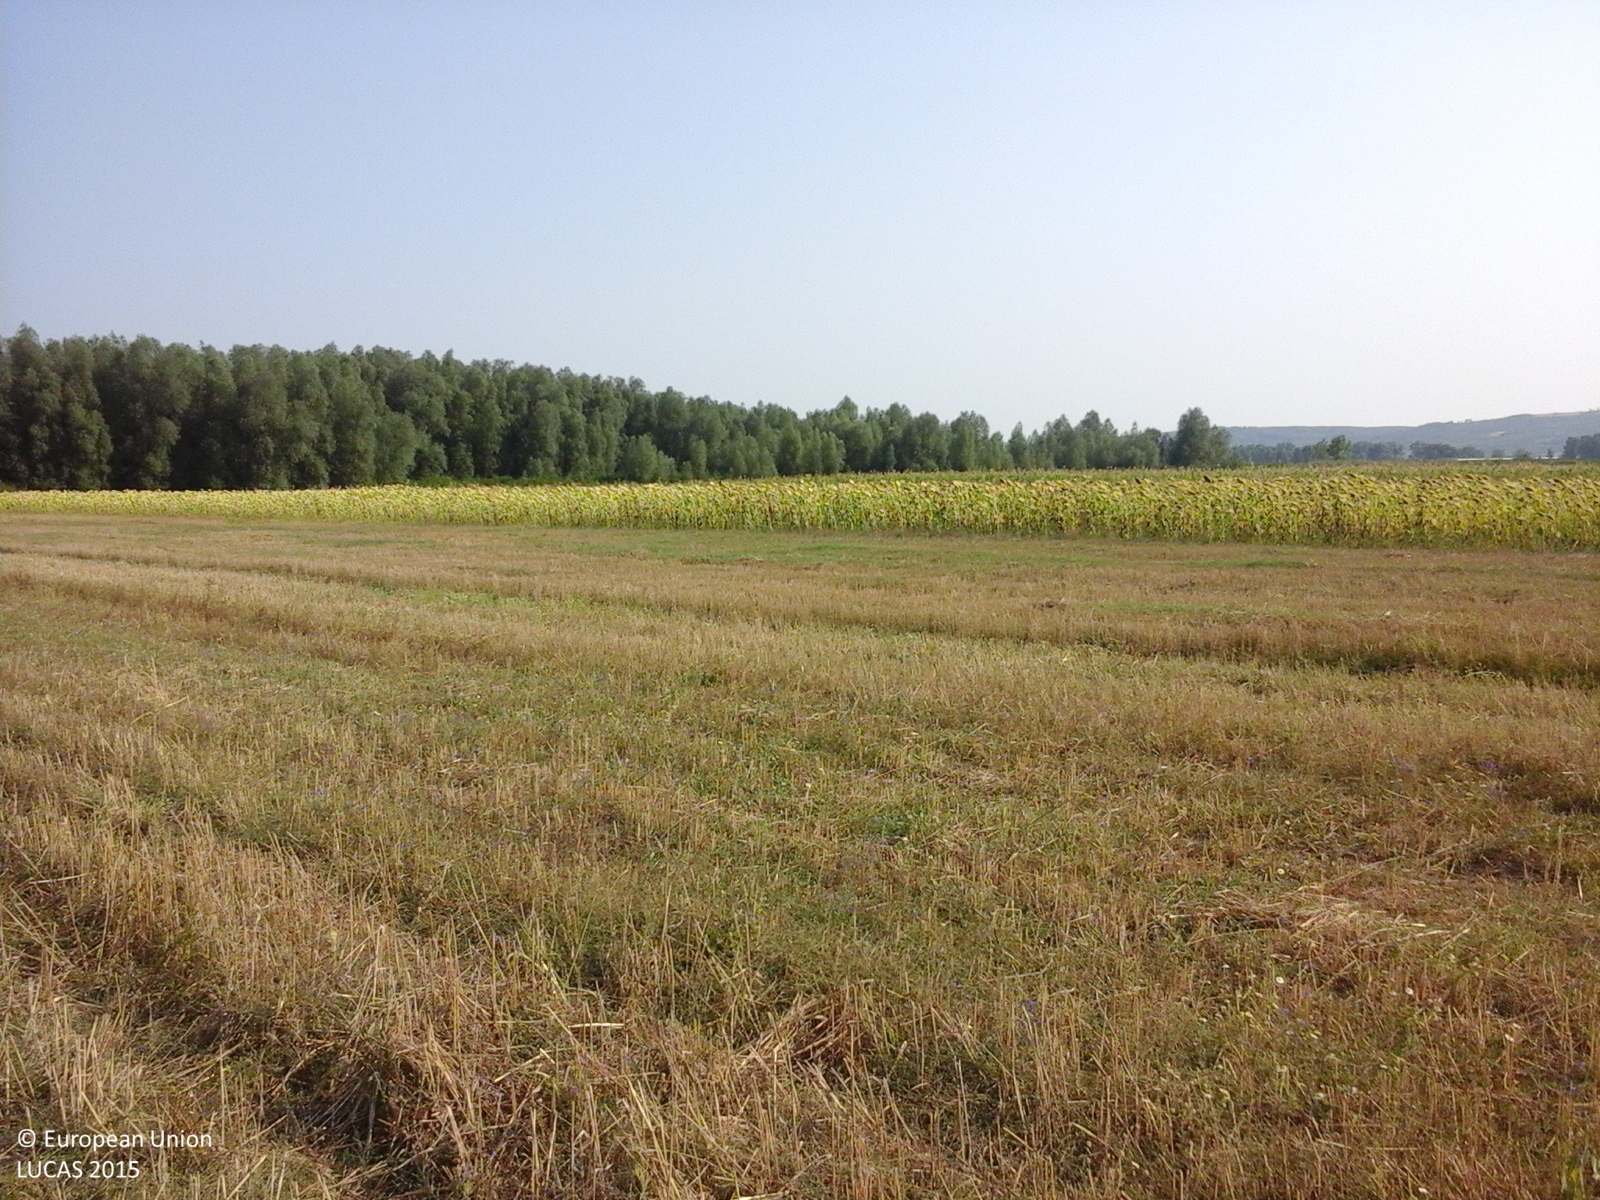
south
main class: Cropland
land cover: Common wheat
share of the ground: 50 - 75 %
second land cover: Spontaneously vegetated surfaces
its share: 25 - 50 %
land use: Agriculture (excluding fallow land and kitchen gardens)
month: August
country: RO
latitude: 44.5161
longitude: 23.5531
